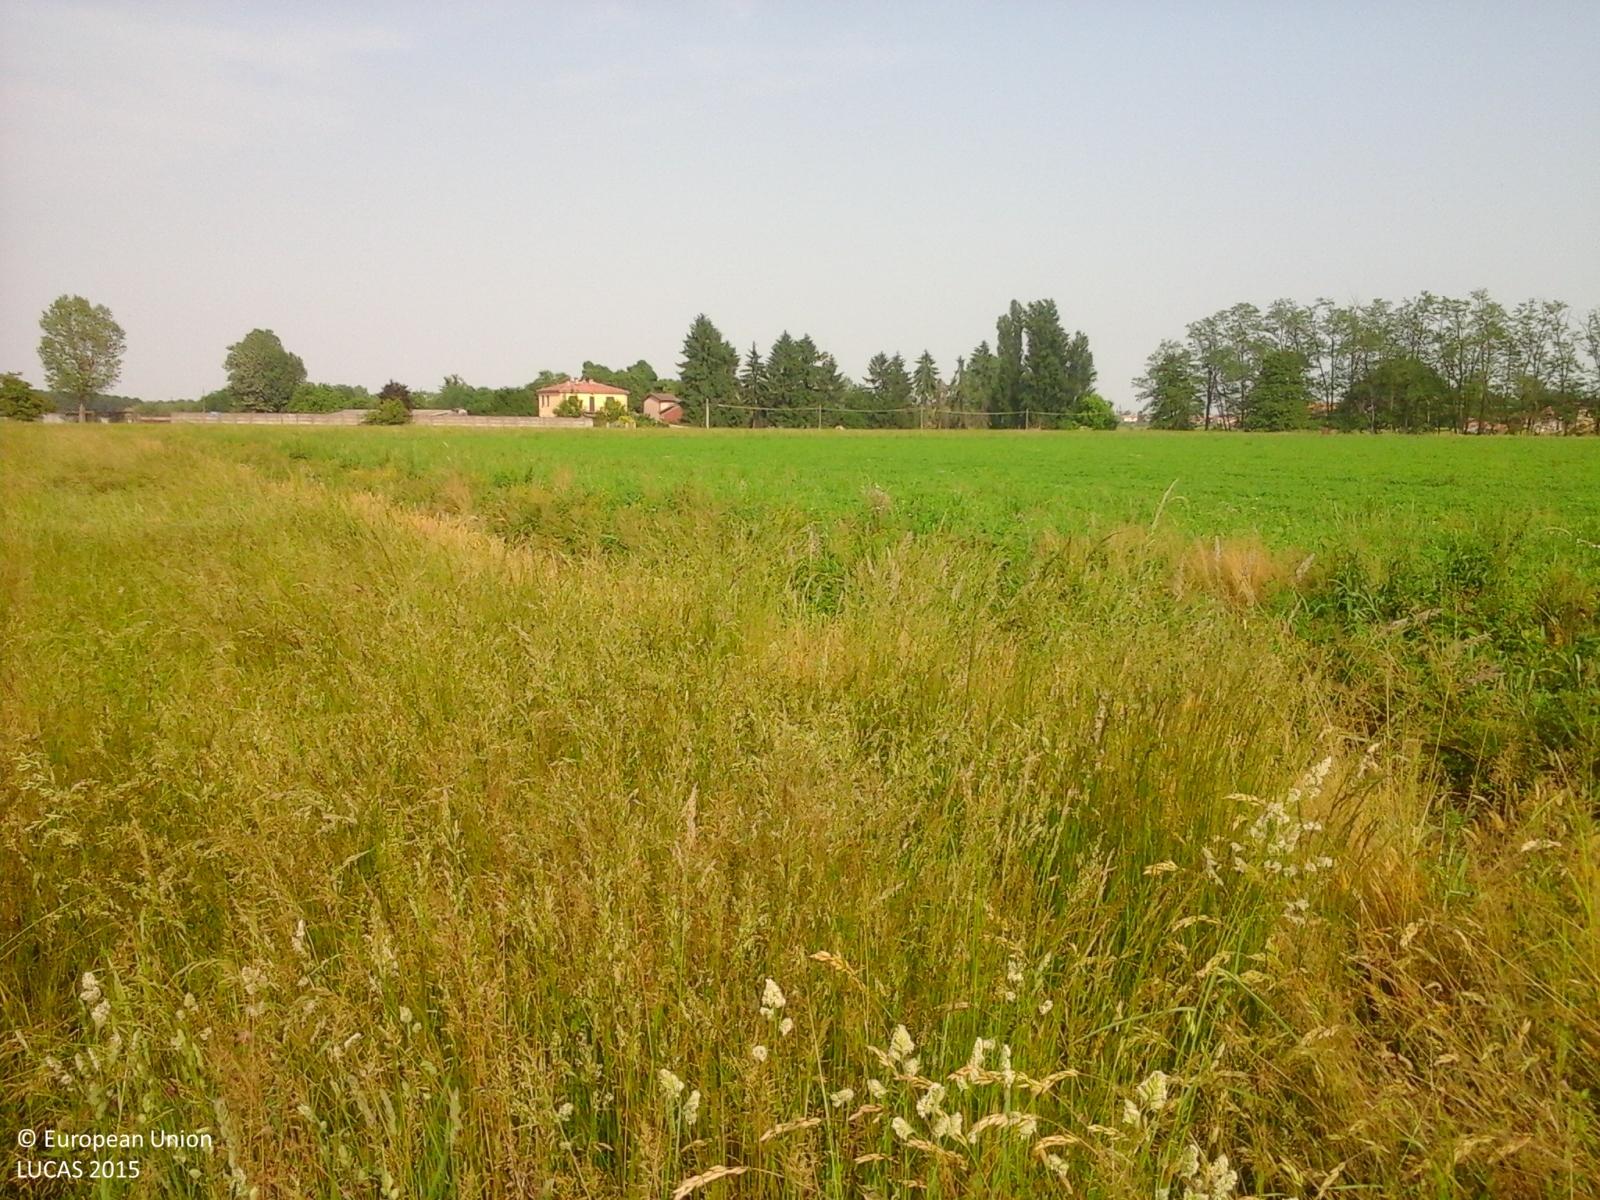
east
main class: Cropland
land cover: Temporary grasslands
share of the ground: > 75 %
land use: Agriculture (excluding fallow land and kitchen gardens)
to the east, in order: Temporary grasslands; Grass margins; Ditches and canals; Grass margins; Temporary grasslands; Grass margins; Paved roads, cycling and walking lanes; Grassland without tree/shrub cover; Fences; Arable land (only in case pi)
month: May
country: IT
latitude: 45.2502
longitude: 9.3768
